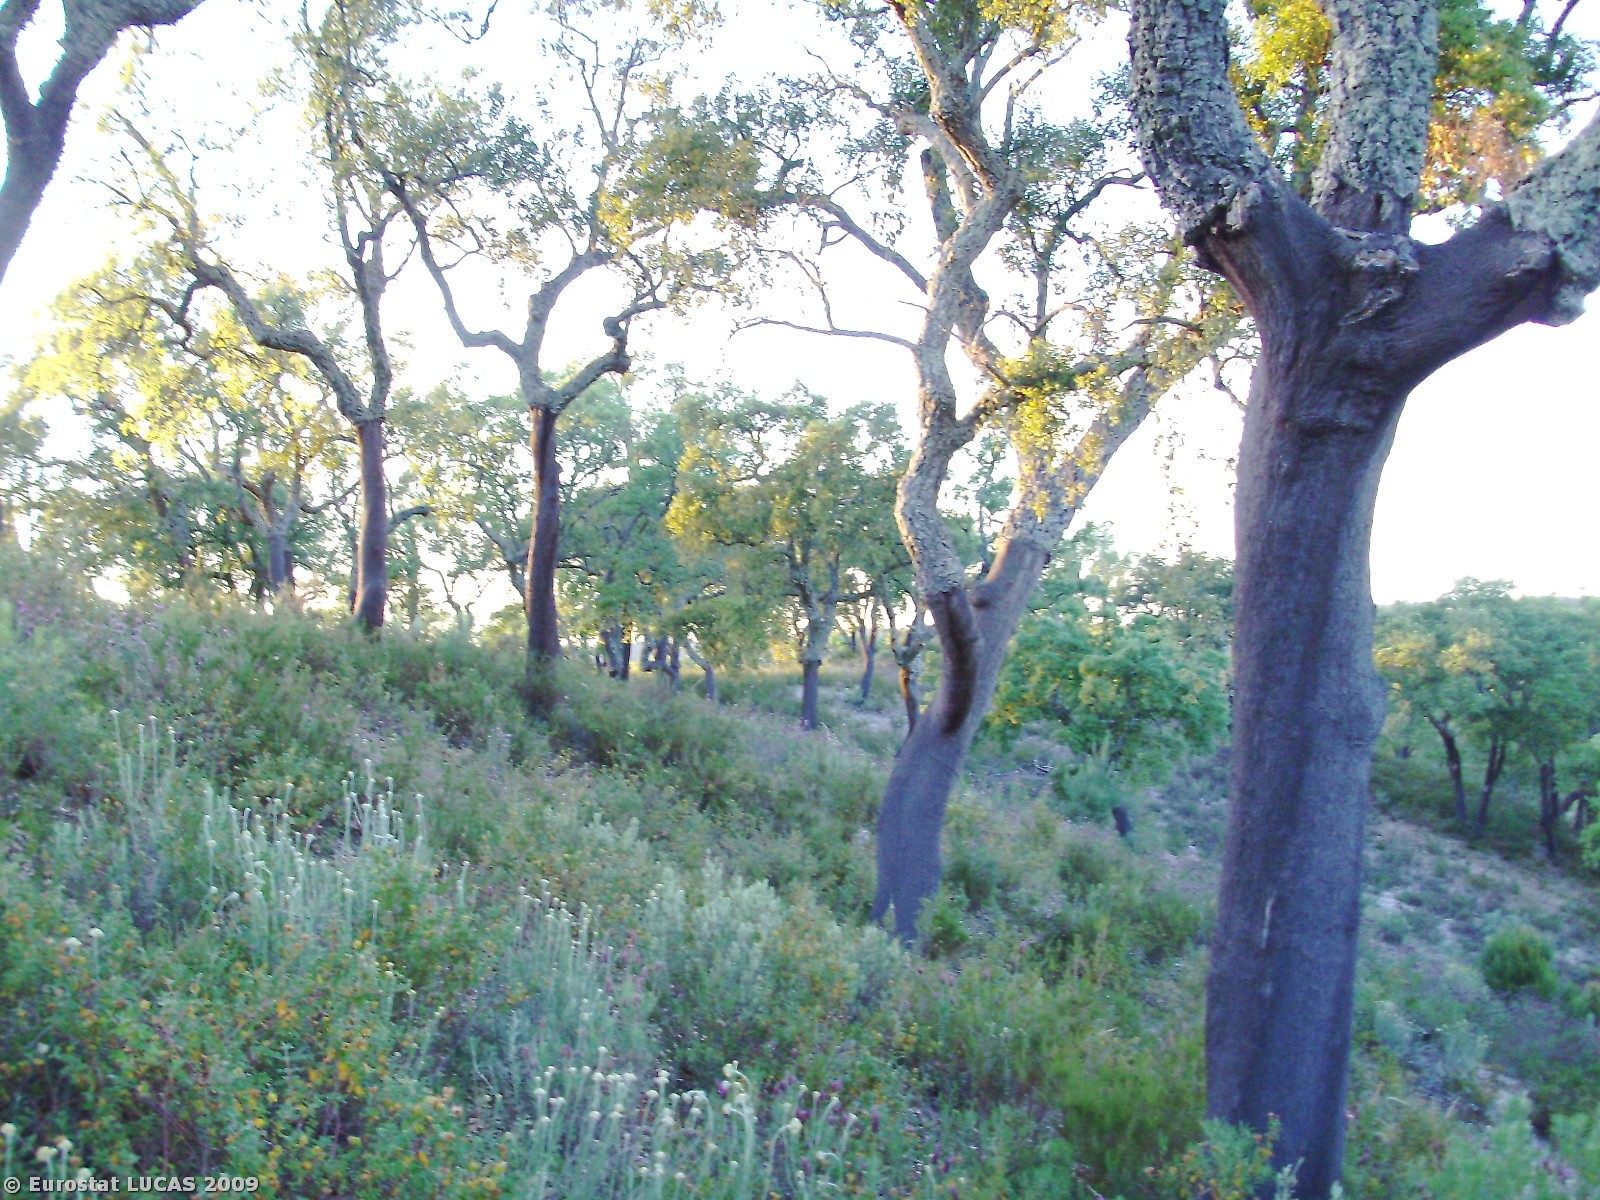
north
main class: Woodland
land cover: Broadleaved woodland
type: broadleaved evergreen forest
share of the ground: 25 - 50 %
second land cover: Spontaneously vegetated surfaces
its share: 50 - 75 %
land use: Forestry
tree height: > 5 m
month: May
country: PT
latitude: 39.1771
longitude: -8.0072
